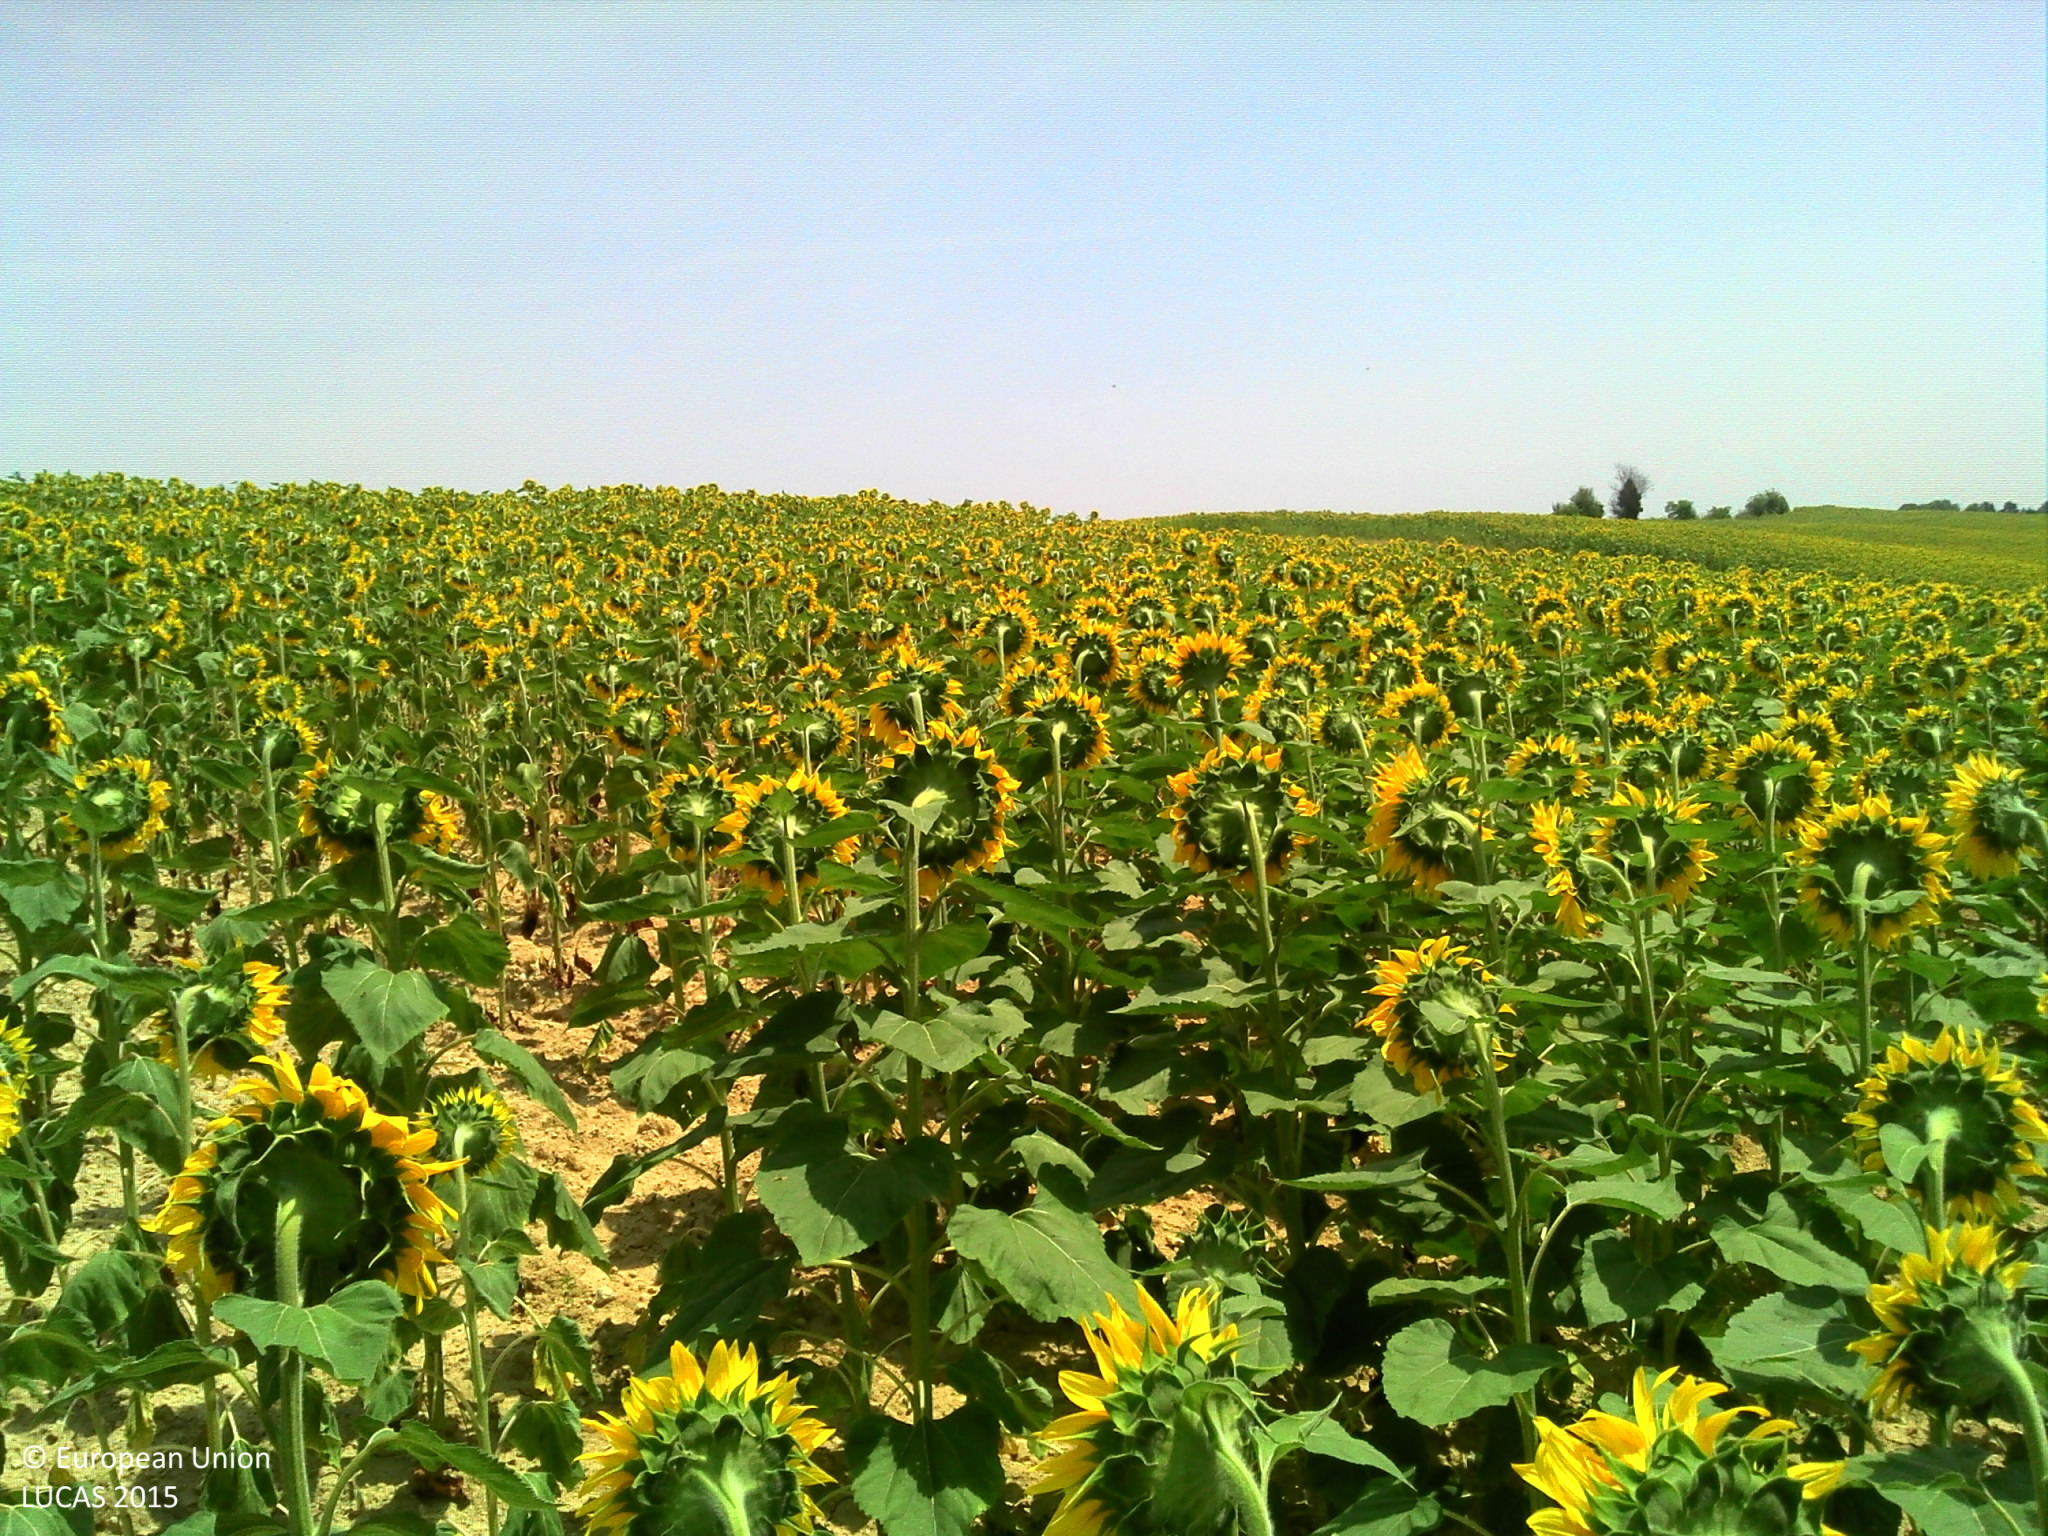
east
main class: Cropland
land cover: Sunflower
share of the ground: > 75 %
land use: Agriculture (excluding fallow land and kitchen gardens)
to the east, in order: Sunflower; Maize; Sunflower; Common wheat
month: July
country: FR
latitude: 43.6893
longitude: 1.0303
